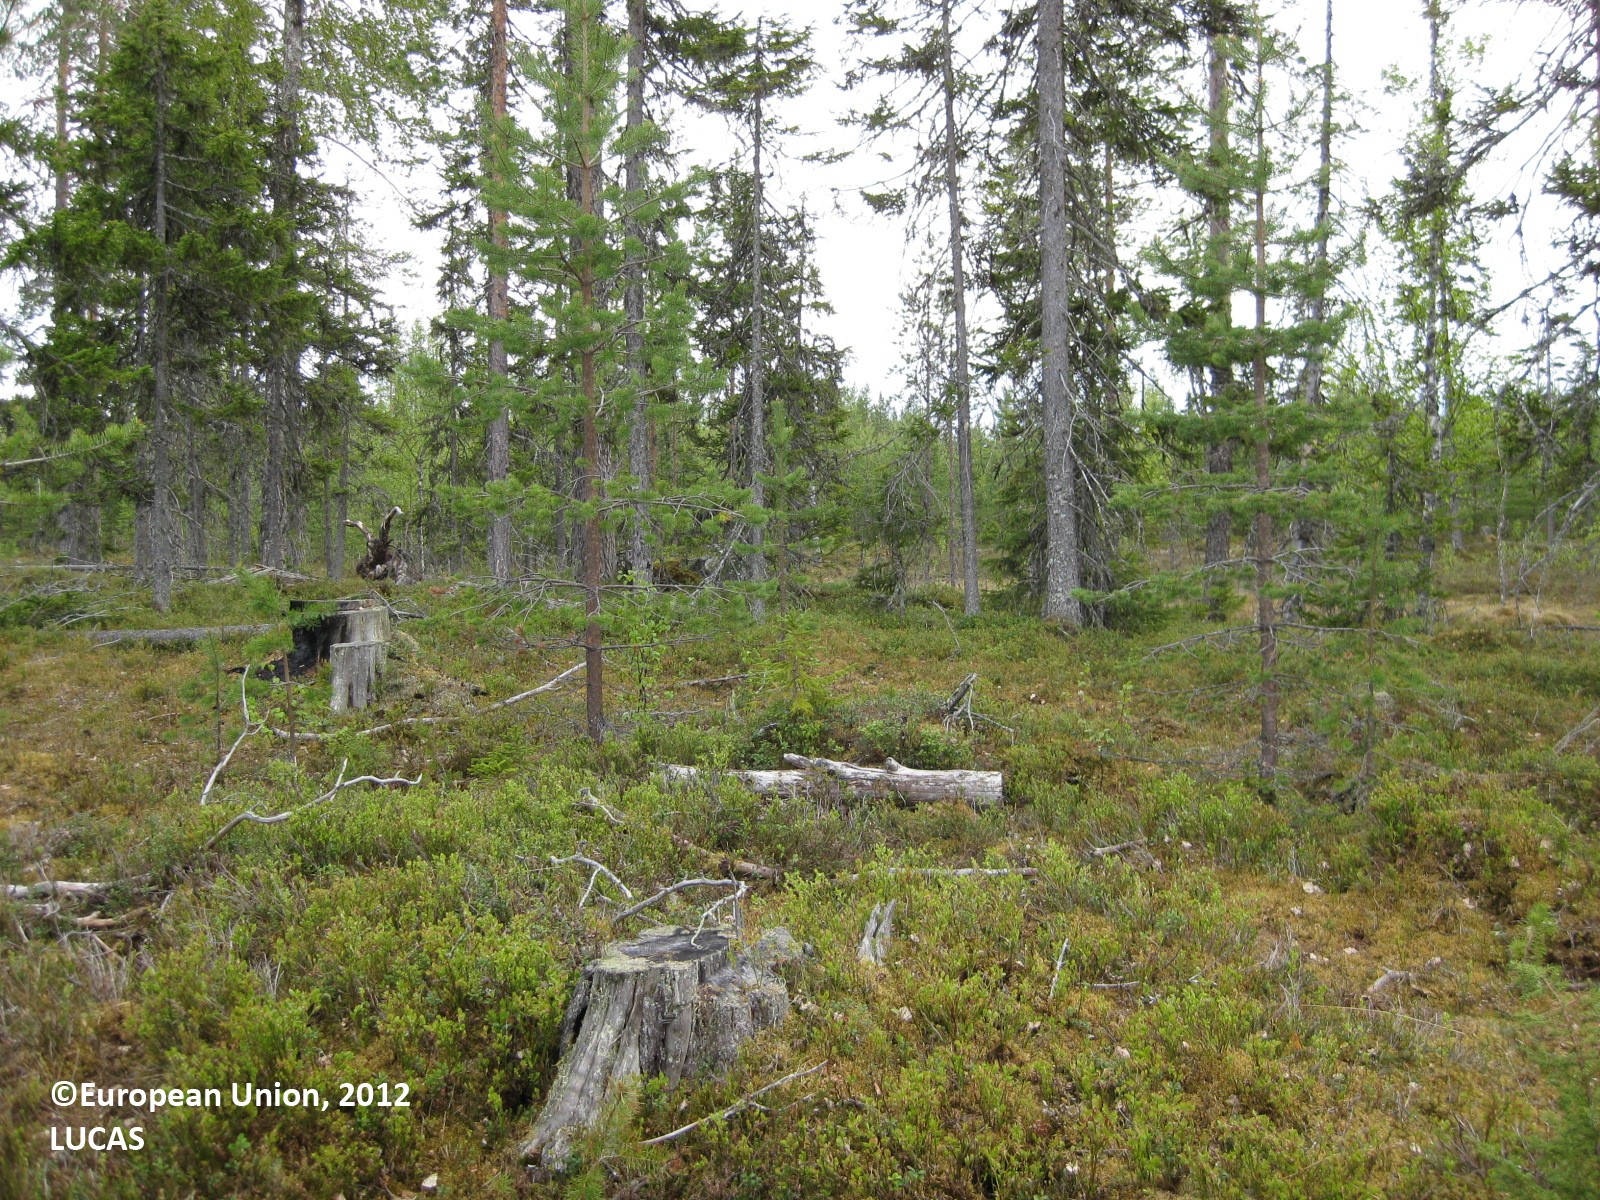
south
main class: Woodland
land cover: Pine dominated coniferous woodland
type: boreal forest
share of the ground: 50 - 75 %
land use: Forestry
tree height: < 5 m
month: June
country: FI
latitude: 65.3672
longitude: 29.3084
